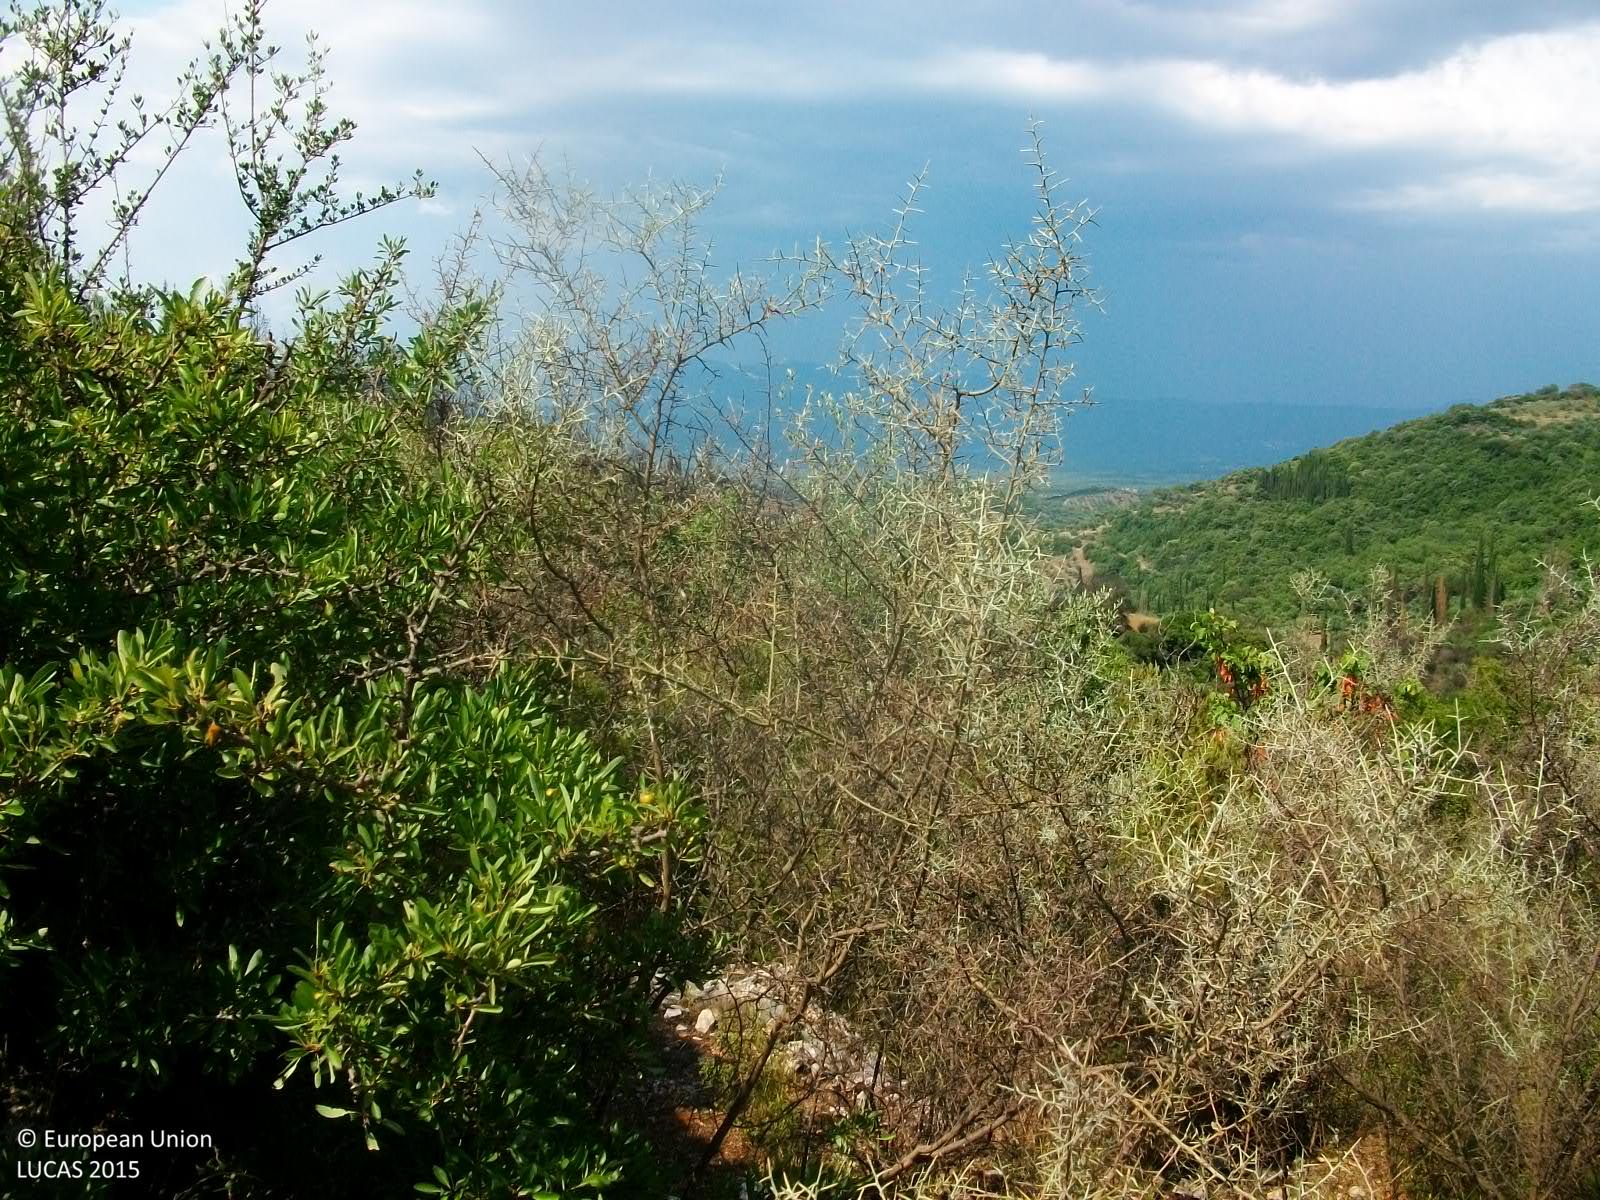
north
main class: Shrubland
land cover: Shrubland with sparse tree cover
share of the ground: > 75 %
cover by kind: shrubs 95 %, broadleaved forest trees 5 %
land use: Semi-natural and natural areas not in use
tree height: > 5 m
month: August
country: GR
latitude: 37.1979
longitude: 21.9082
